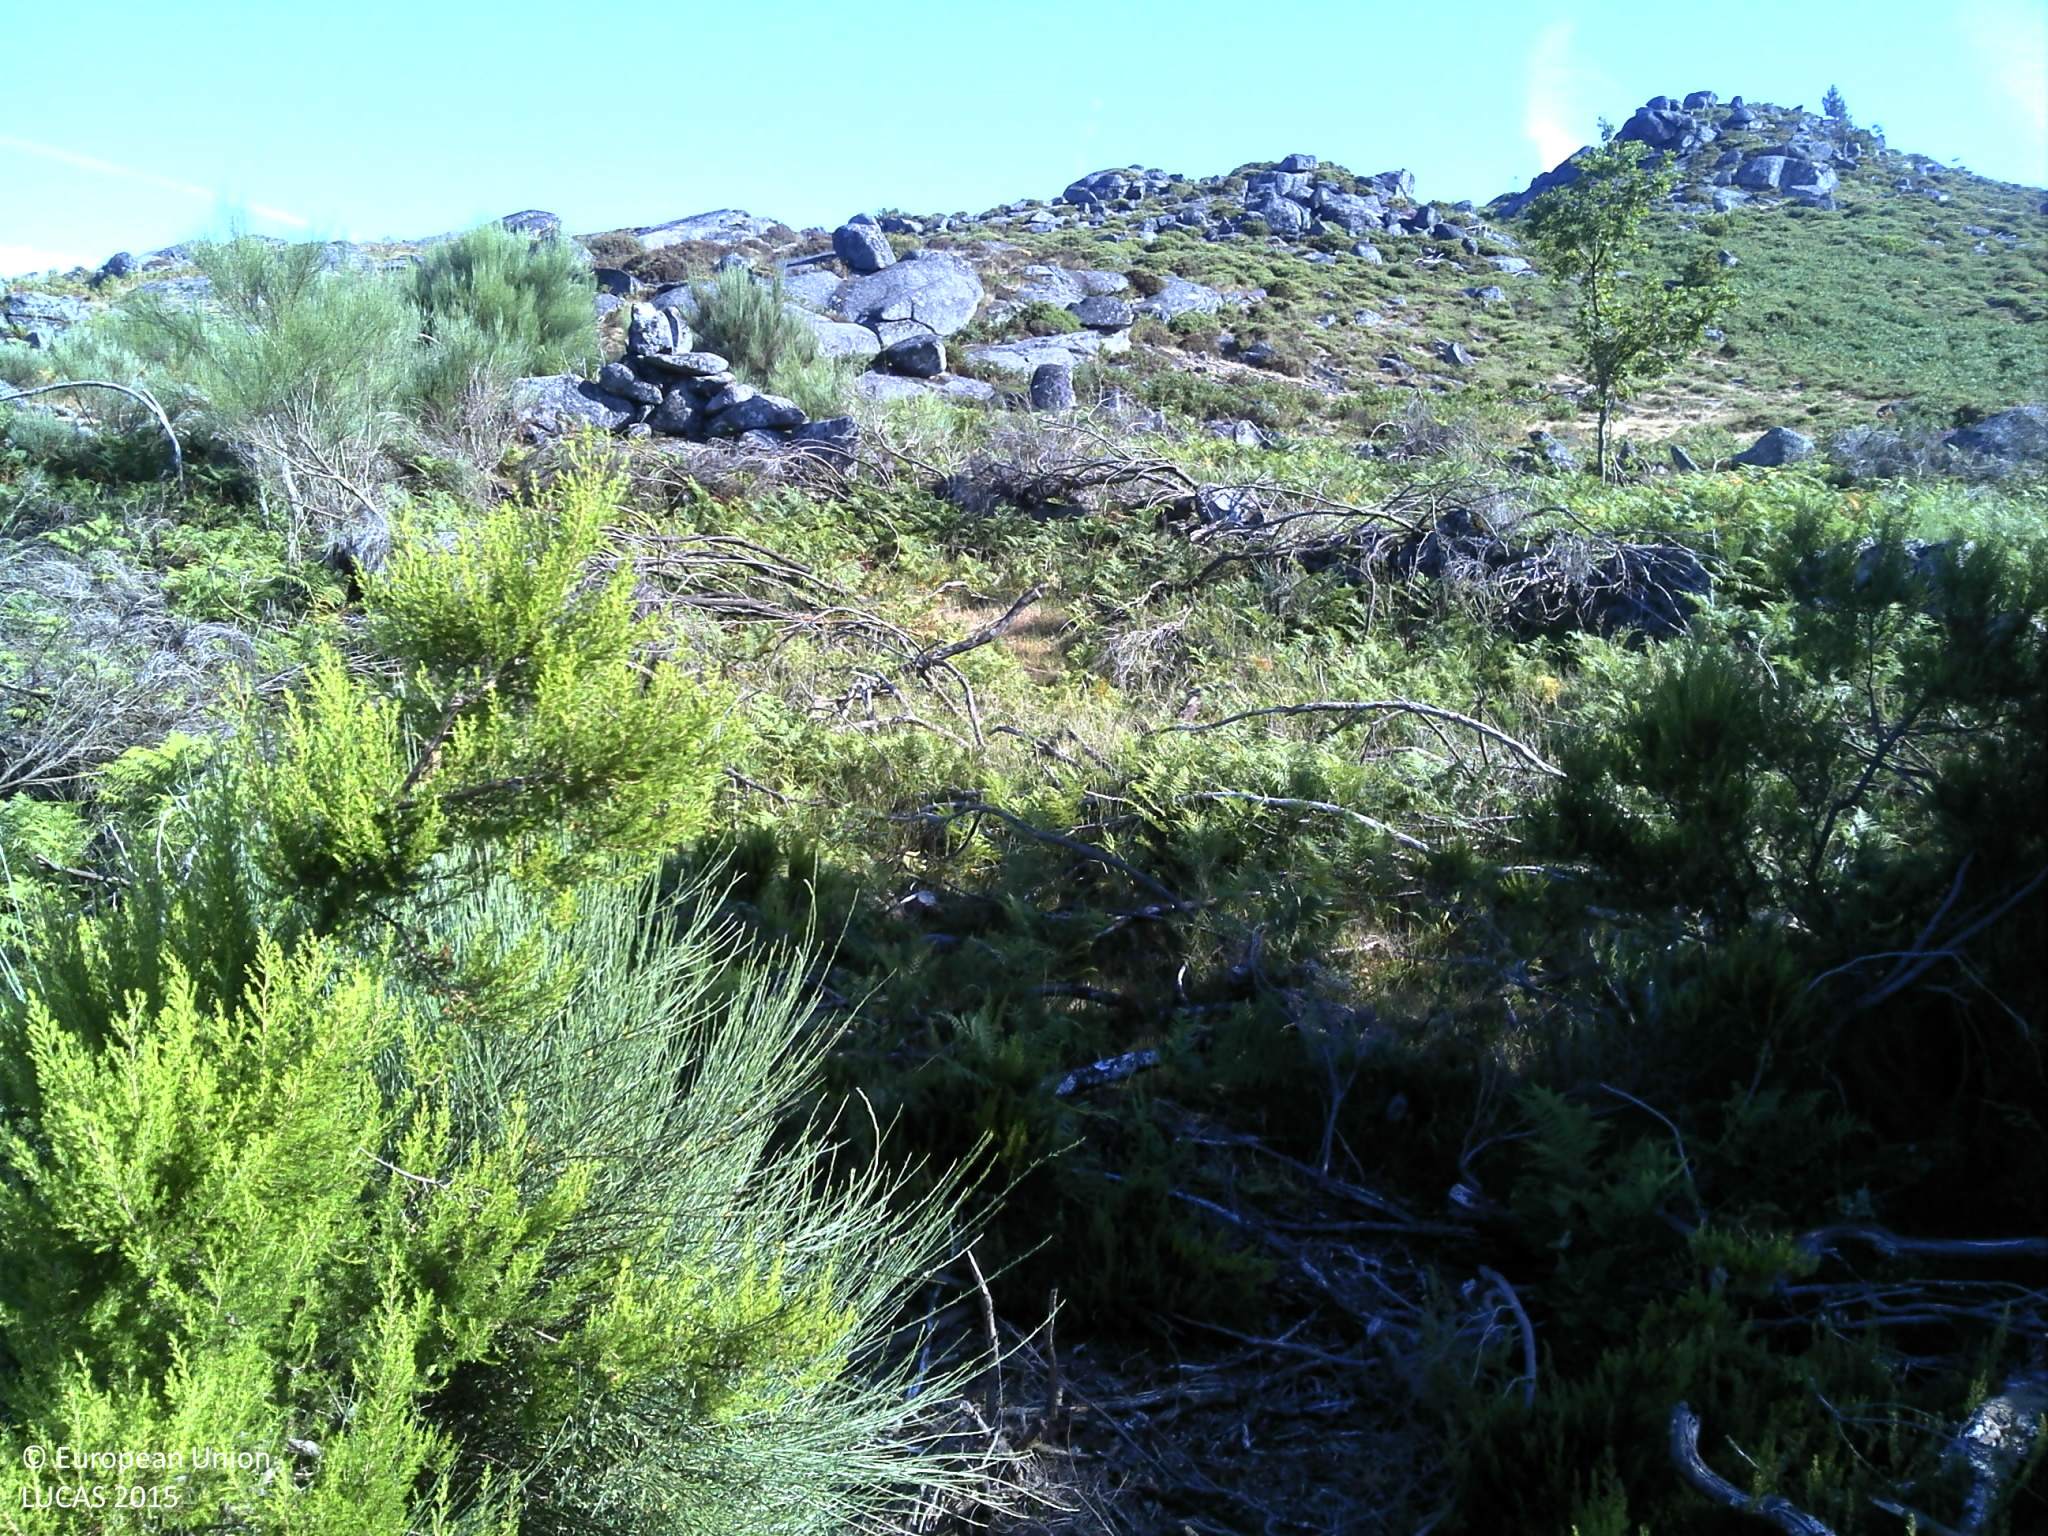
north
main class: Shrubland
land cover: Shrubland with sparse tree cover
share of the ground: > 75 %
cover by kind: shrubs 80 %, herbaceous plants 10 %, broadleaved forest trees 5 %, unconsolidated bare surface 5 %
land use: Agriculture (excluding fallow land and kitchen gardens)
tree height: < 5 m
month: July
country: PT
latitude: 41.4254
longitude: -7.8323
